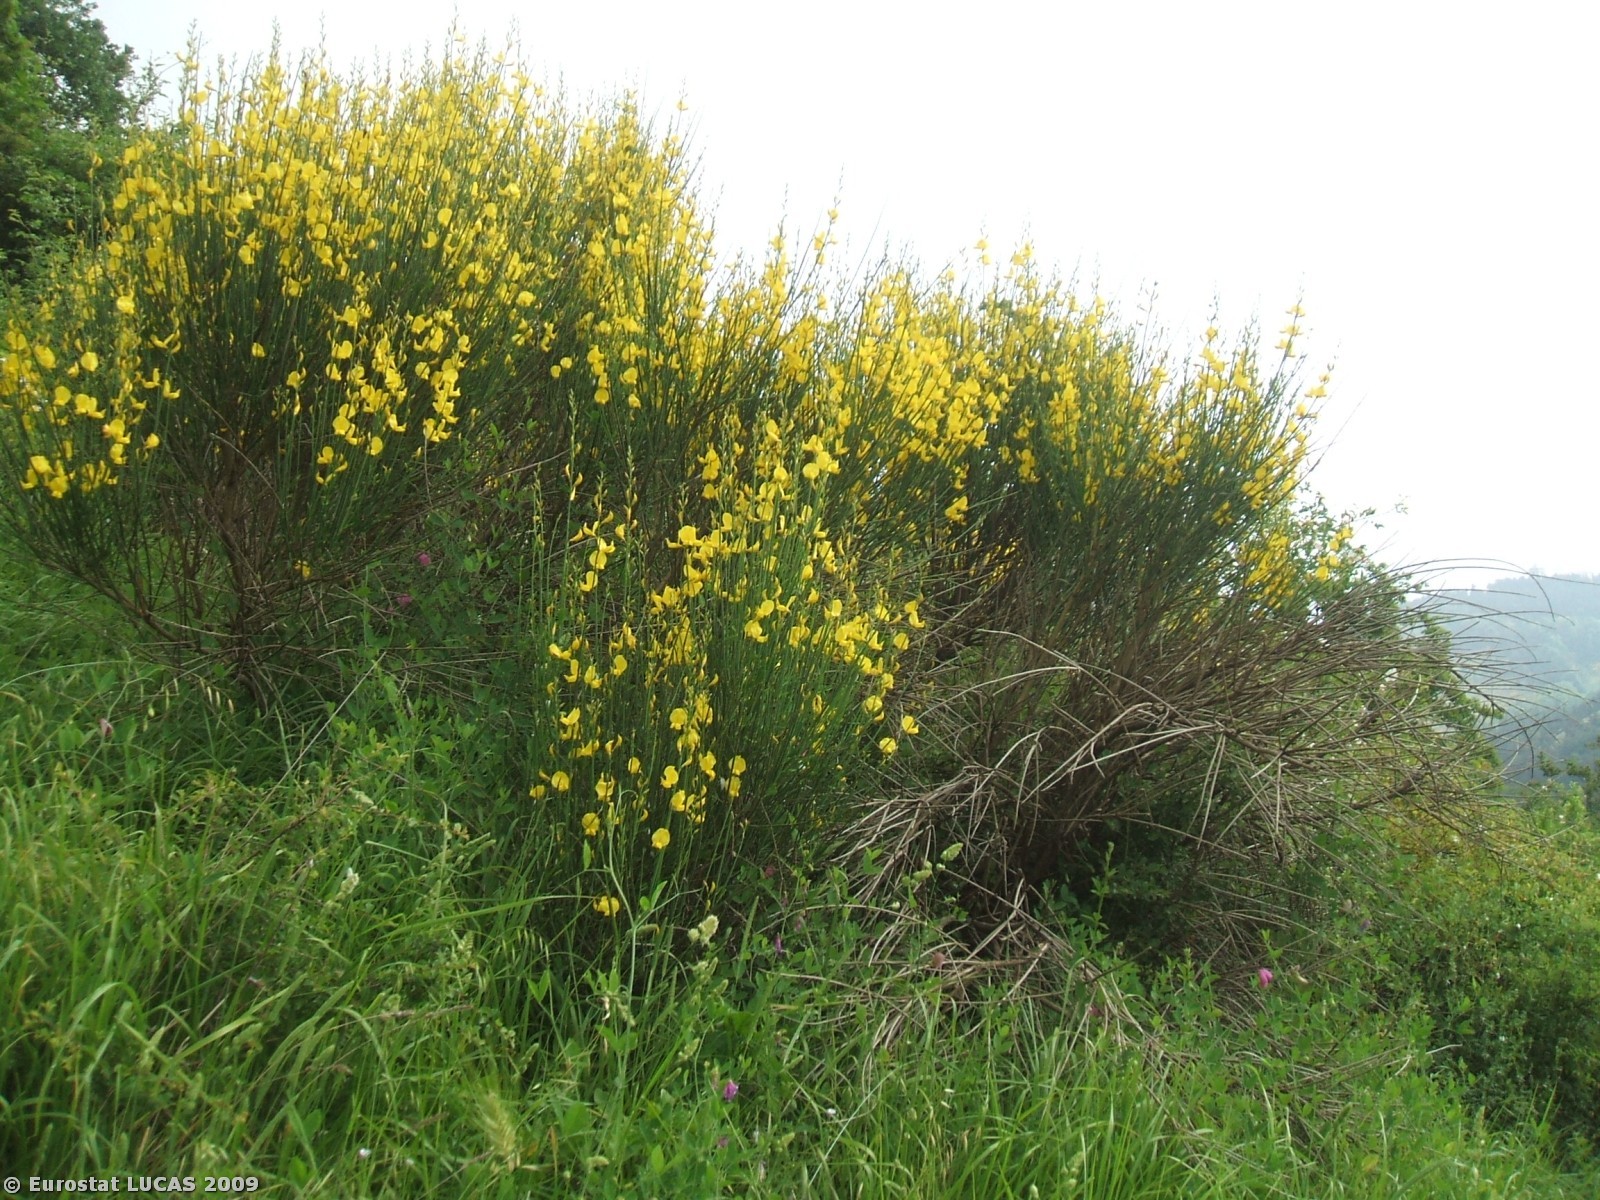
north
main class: Shrubland
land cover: Shrubland without tree cover
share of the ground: > 75 %
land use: Fallow land
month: May
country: IT
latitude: 40.4879
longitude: 15.6047
